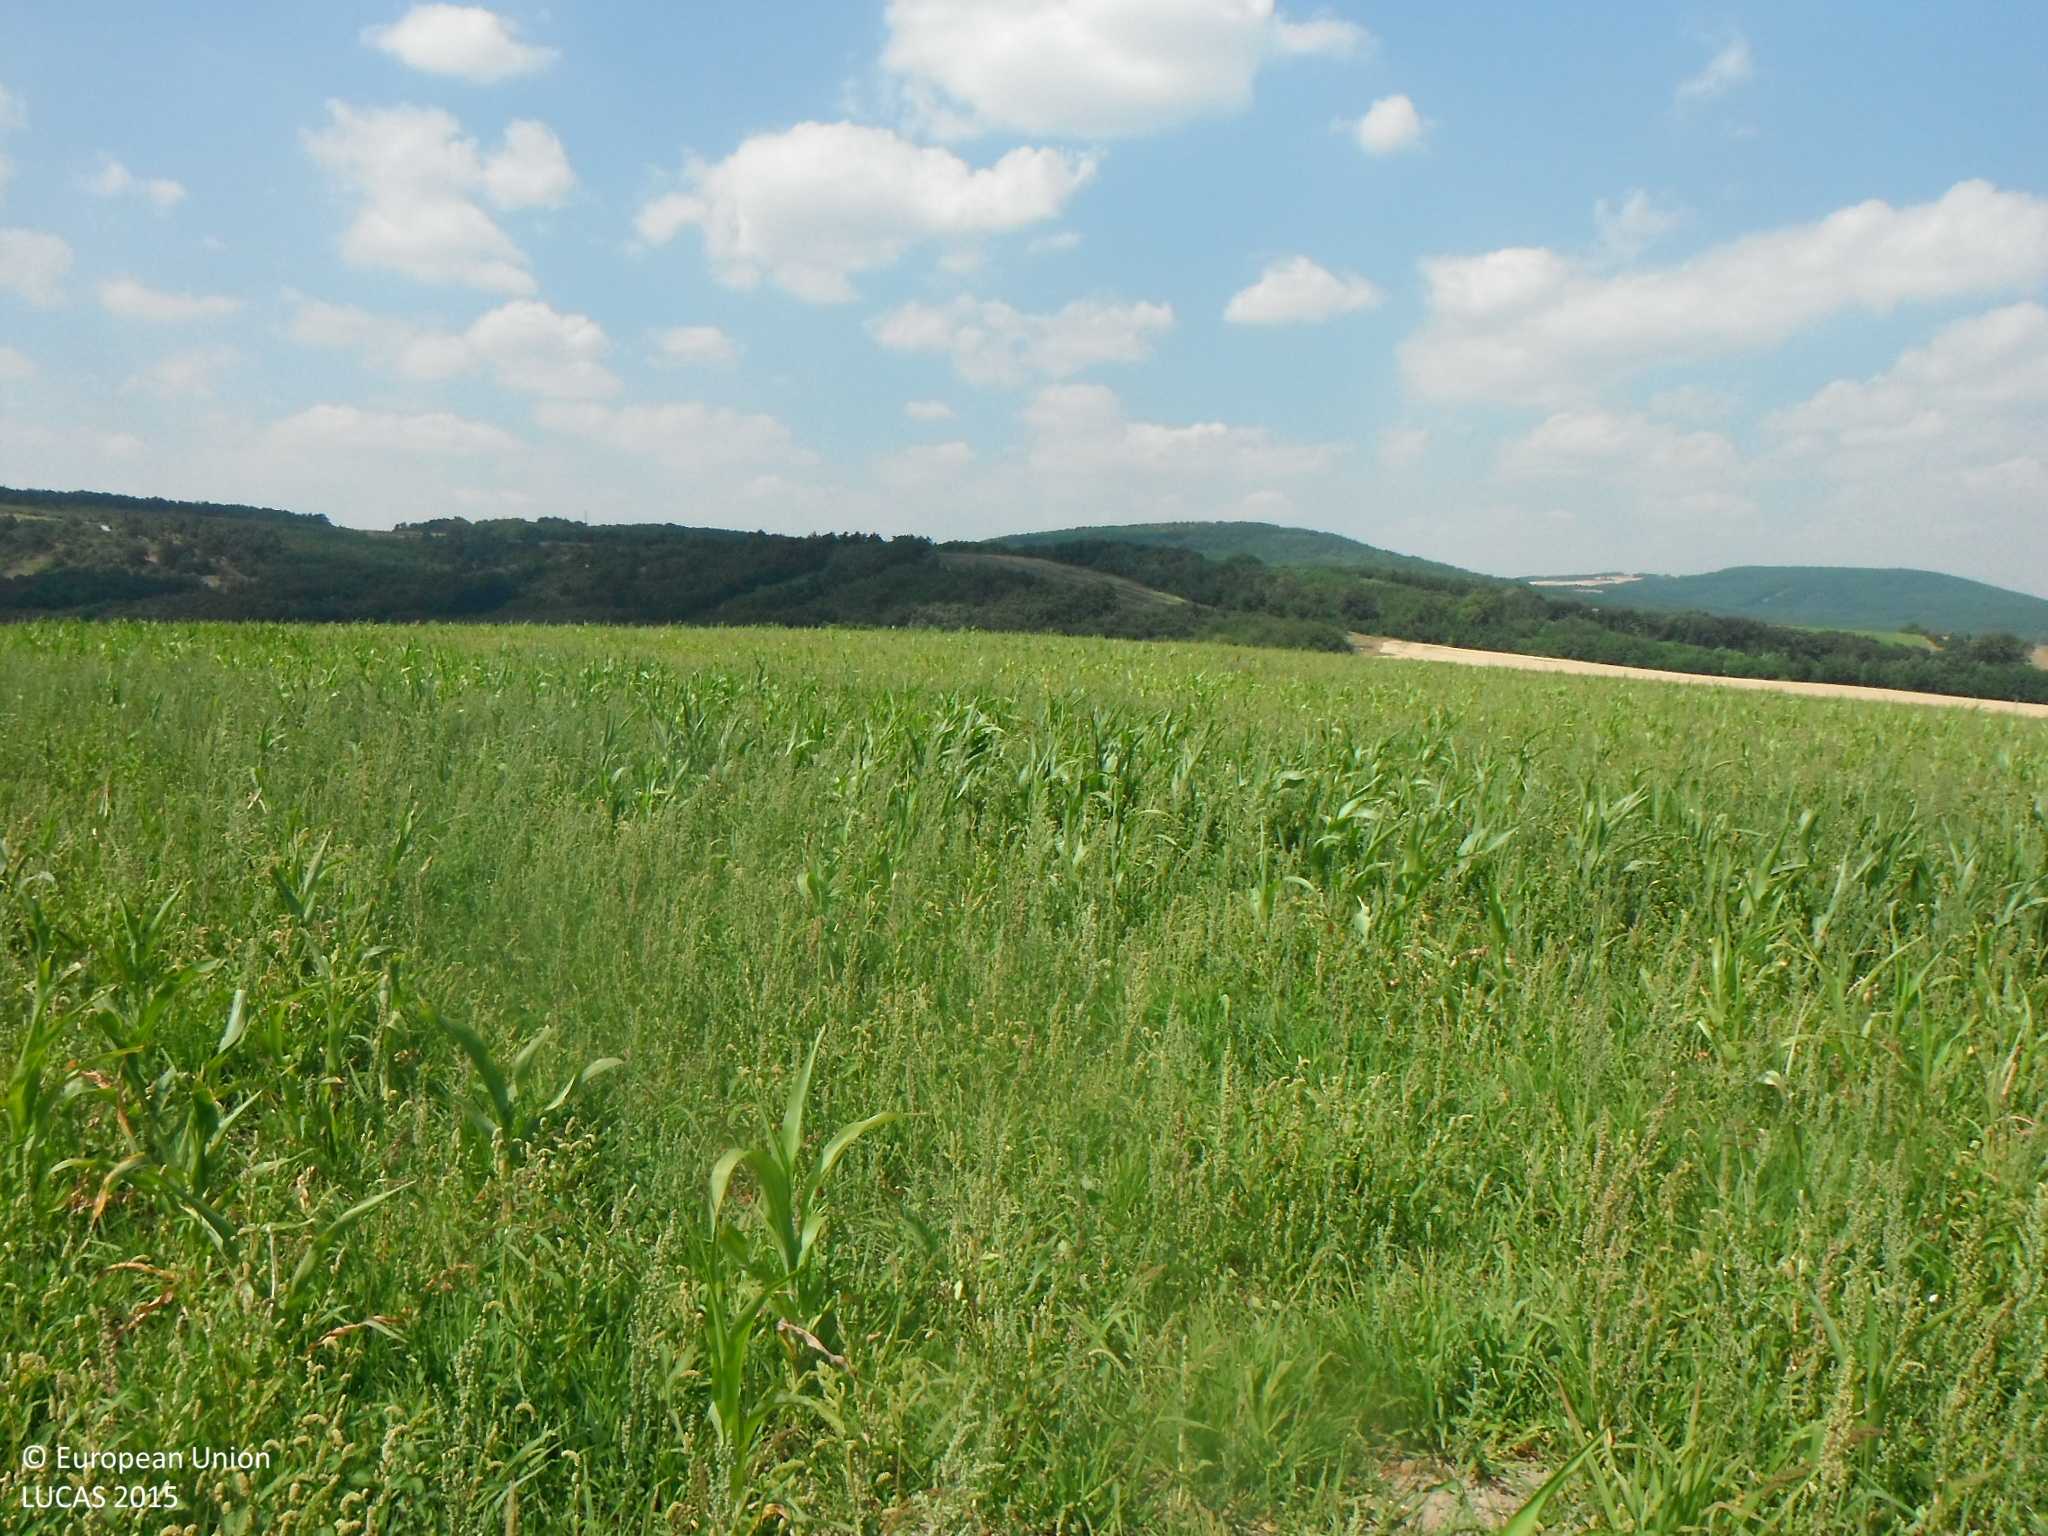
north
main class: Cropland
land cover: Maize
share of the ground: 25 - 50 %
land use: Agriculture (excluding fallow land and kitchen gardens)
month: July
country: SK
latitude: 48.1035
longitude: 19.0579
